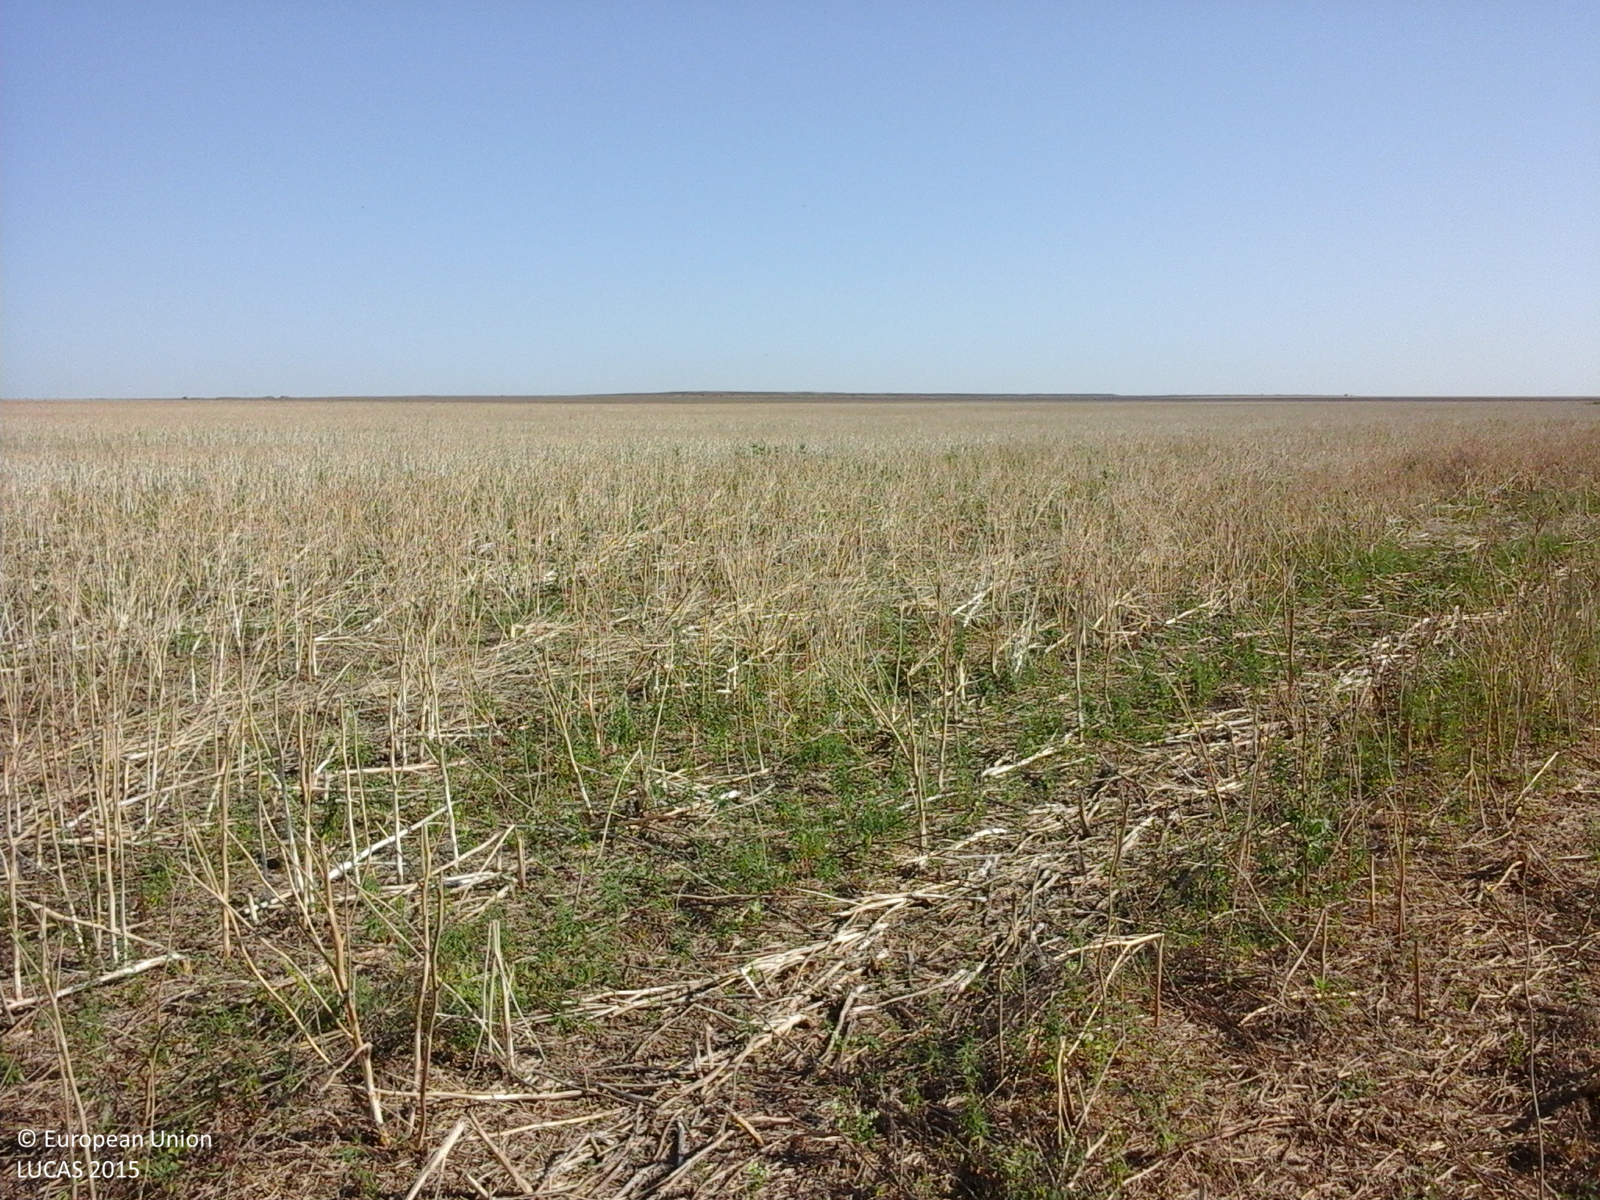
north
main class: Cropland
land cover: Rape and turnip rape
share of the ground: 25 - 50 %
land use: Agriculture (excluding fallow land and kitchen gardens)
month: August
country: RO
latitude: 44.2889
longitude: 28.4277
